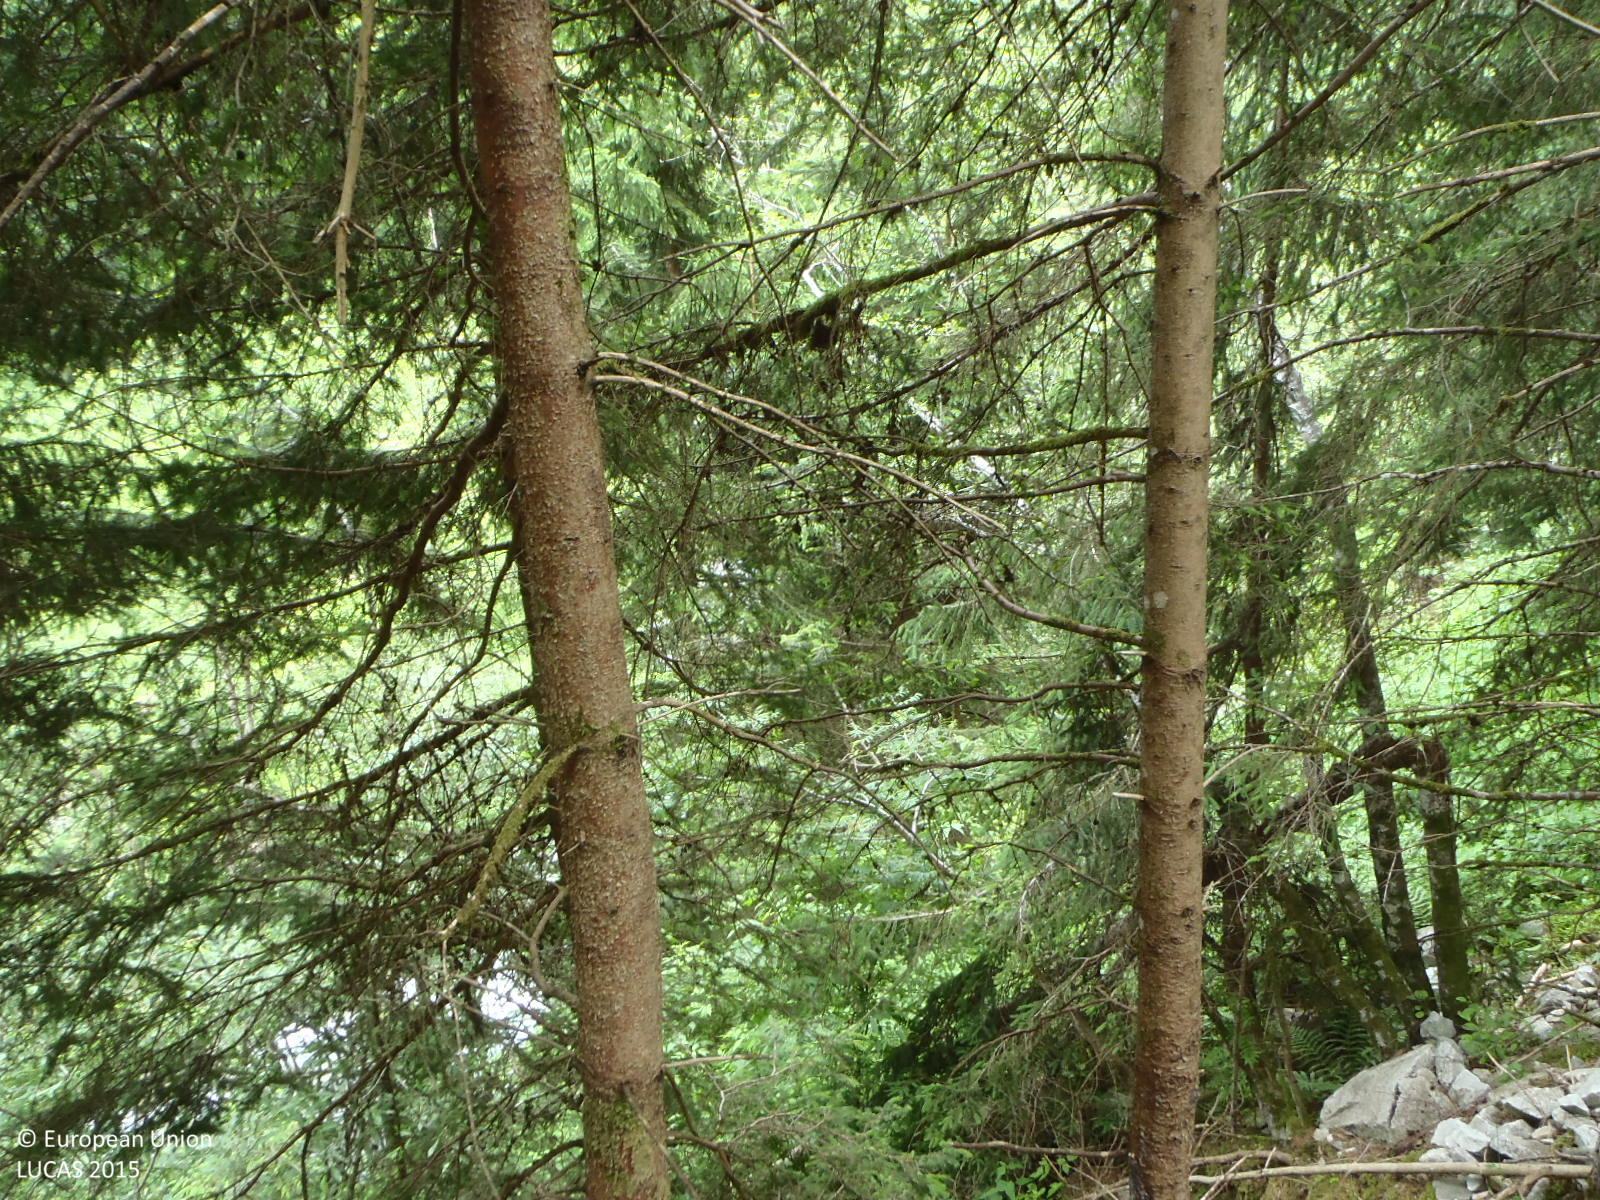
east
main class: Woodland
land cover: Spruce dominated coniferous woodland
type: alpine coniferous forest
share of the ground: > 75 %
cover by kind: coniferous forest trees 80 %, herbaceous plants 10 %, shrubs 5 %, lichens and mosses 5 %
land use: Forestry
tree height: > 5 m
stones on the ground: < 10 %
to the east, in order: Spruce dominated coniferous woodland; Spruce dominated mixed woodland; Inland fresh running water; Grassland with sparse tree/shrub cover; Spruce dominated coniferous woodland; Grassland without tree/shrub cover; Electric lines; Grassland without tree/shrub cover; Spruce dominated coniferous woodland; Shrubland without tree cover
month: June
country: AT
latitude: 47.2229
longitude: 12.4940
